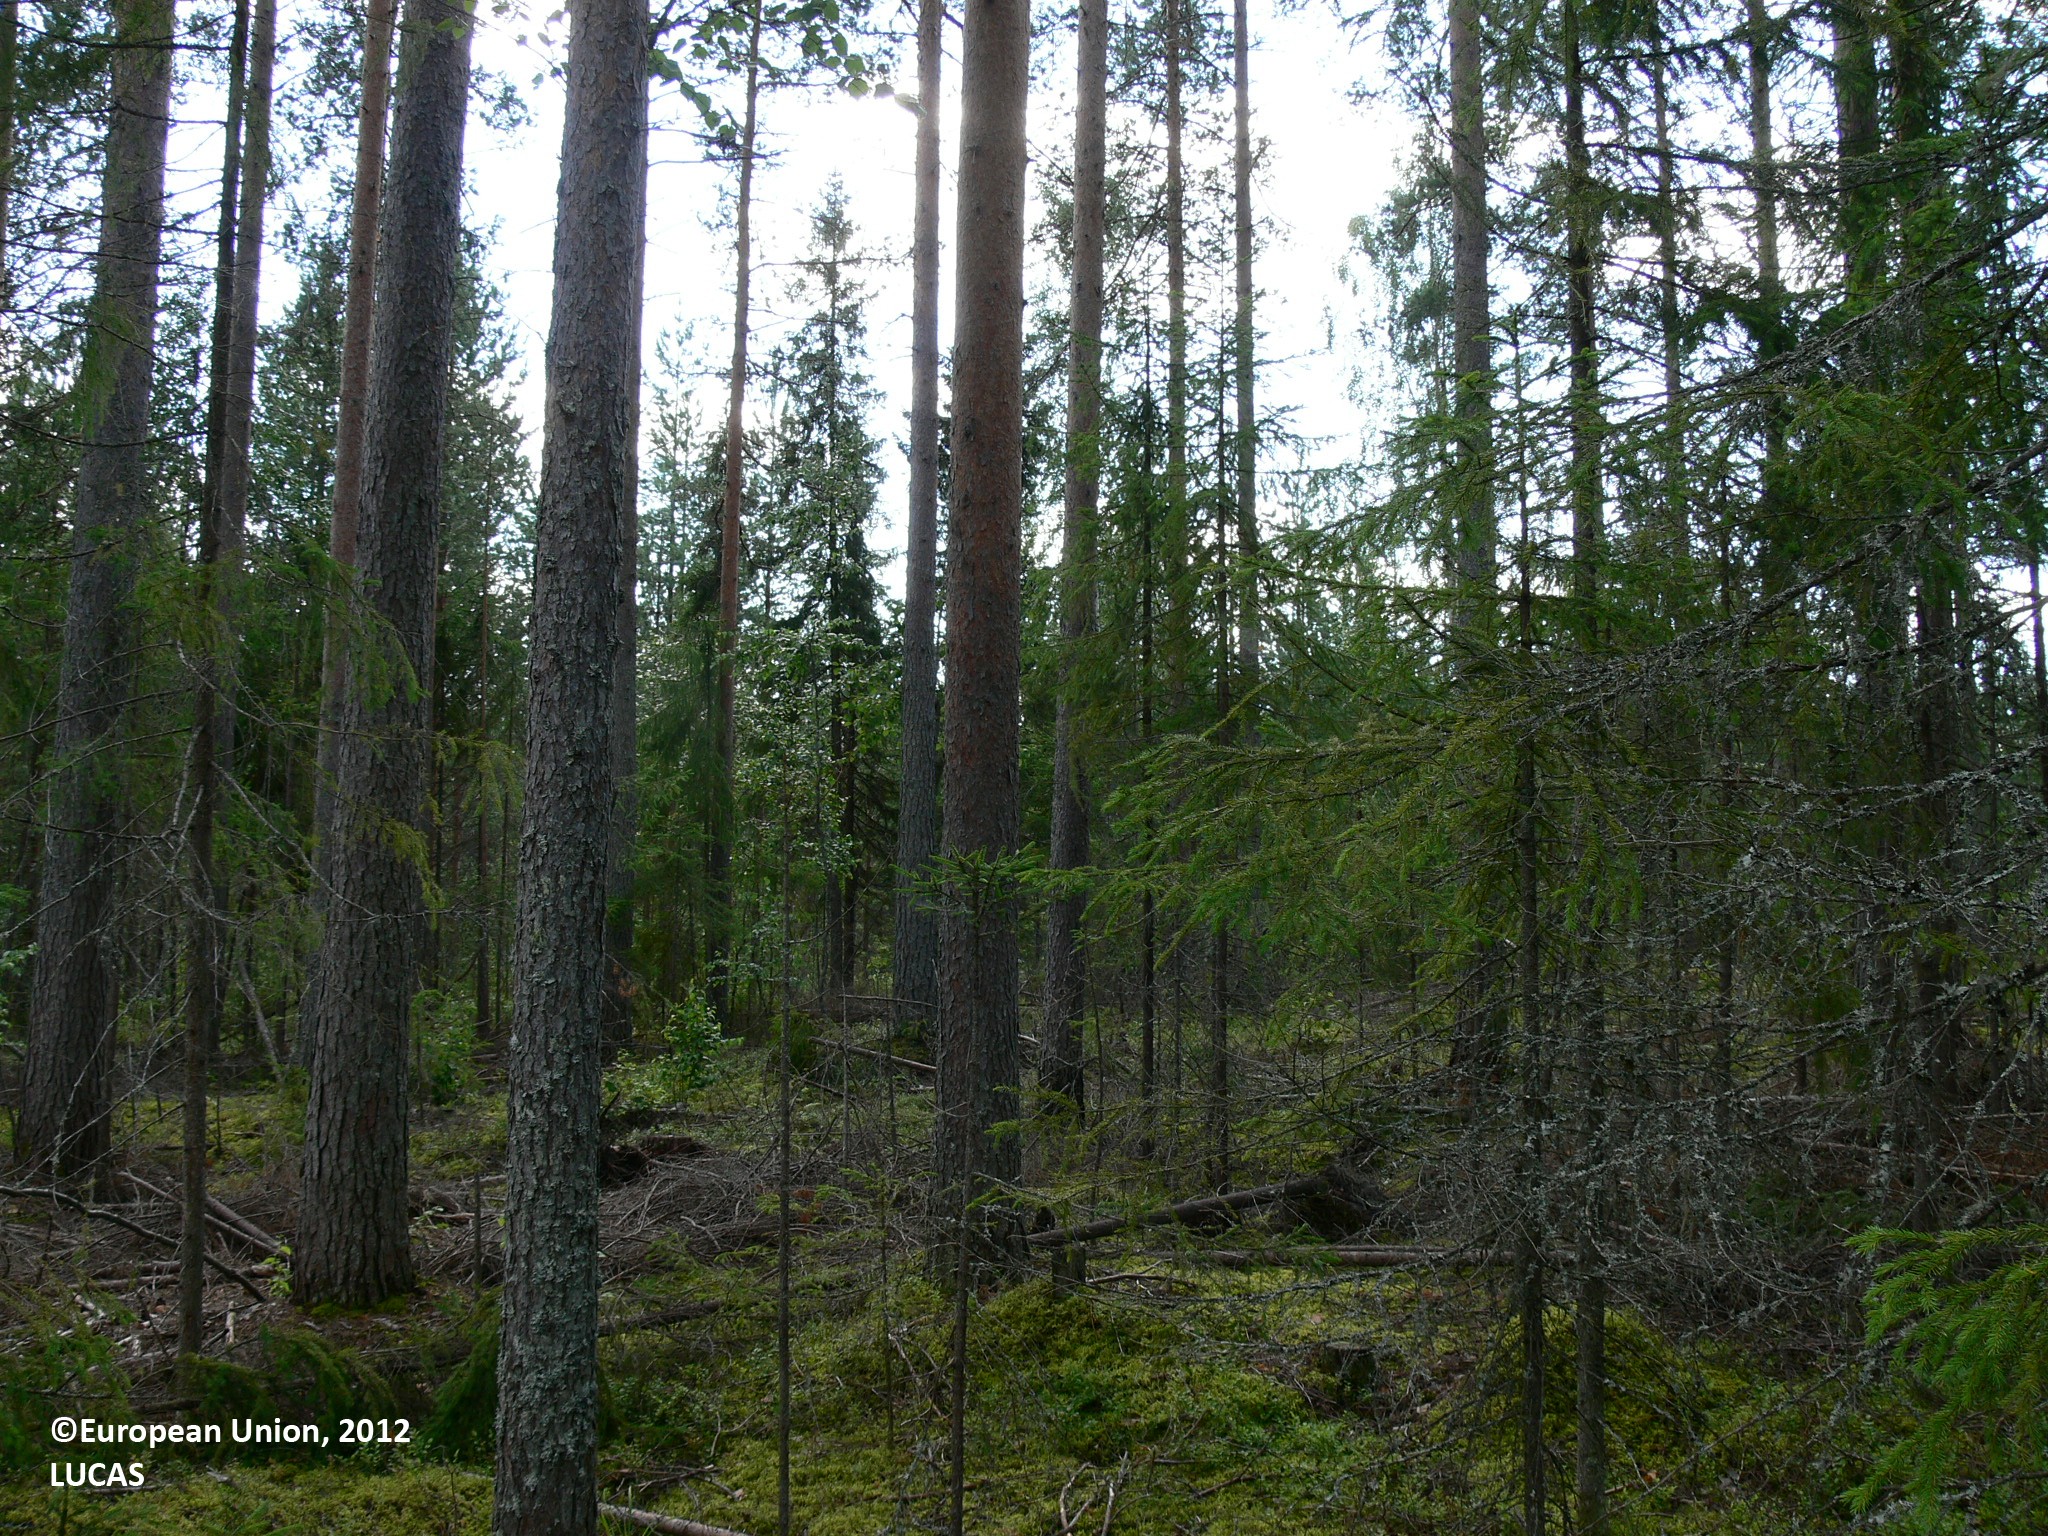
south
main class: Woodland
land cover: Pine dominated coniferous woodland
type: boreal forest
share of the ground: 50 - 75 %
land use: Forestry
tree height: > 5 m
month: July
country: FI
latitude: 63.2004
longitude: 29.2461
